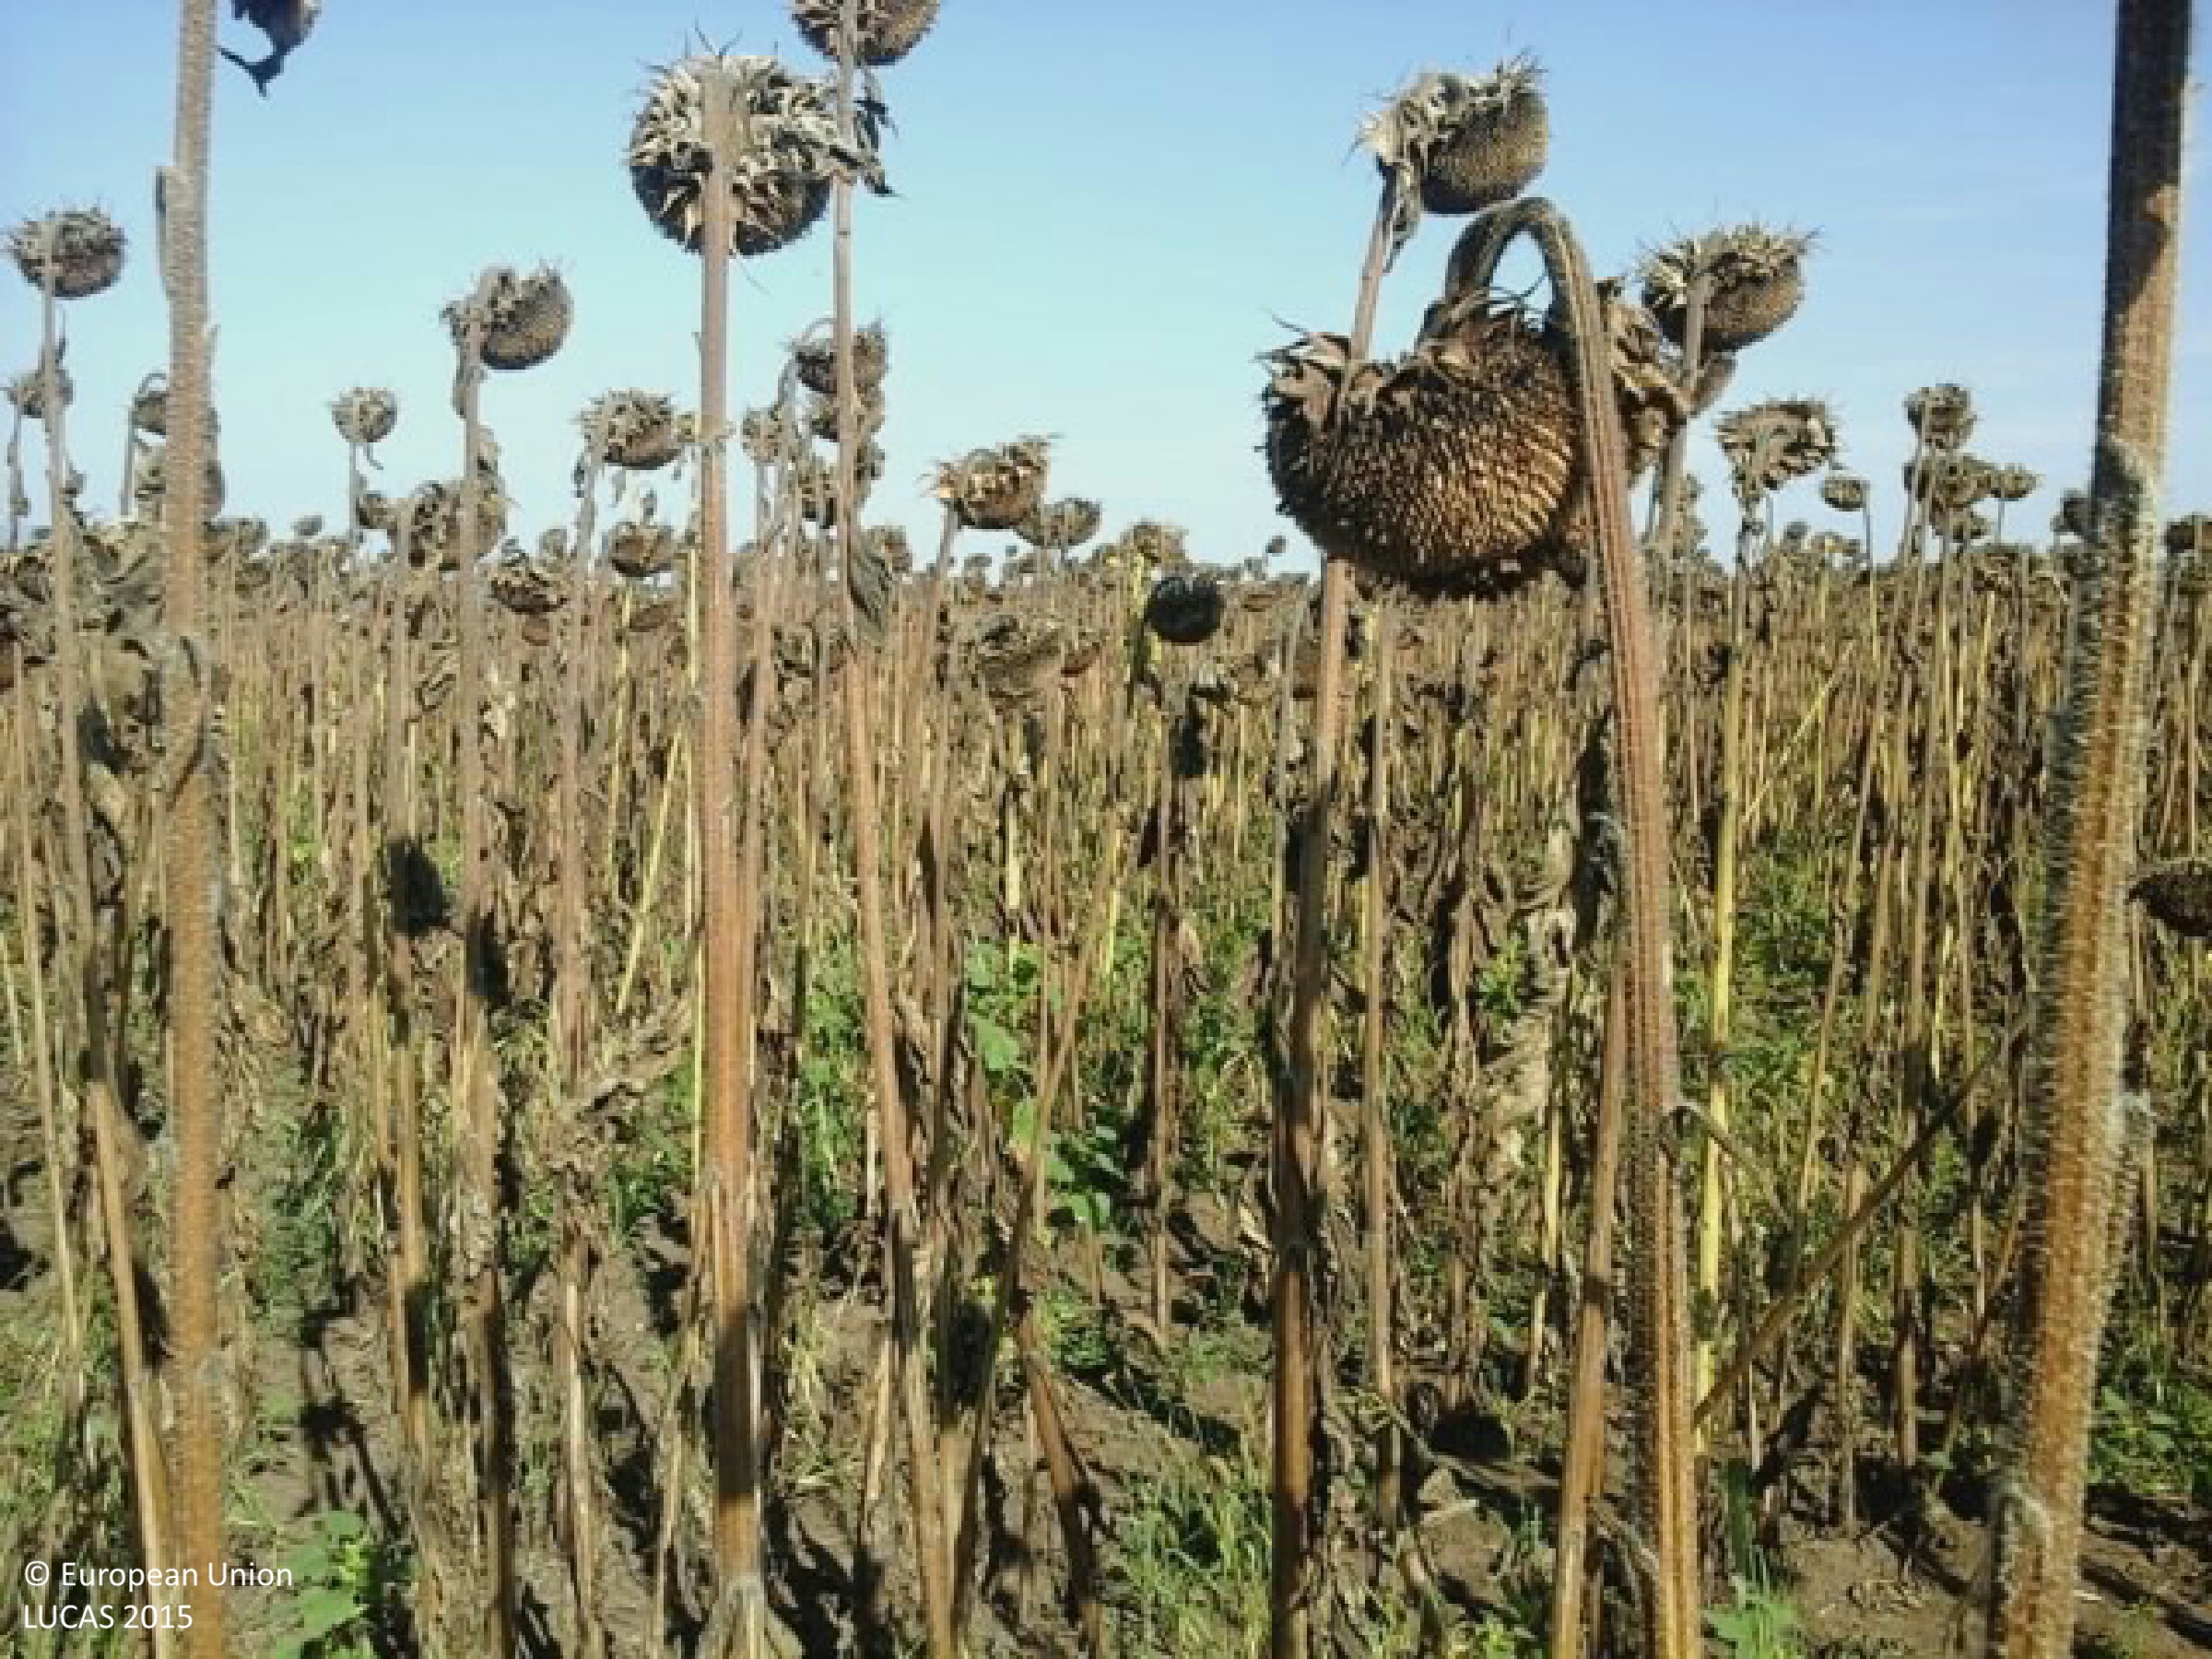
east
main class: Cropland
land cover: Sunflower
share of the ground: > 75 %
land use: Agriculture (excluding fallow land and kitchen gardens)
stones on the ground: < 10 %
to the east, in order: Sunflower
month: September
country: HU
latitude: 47.6426
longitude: 19.7816
